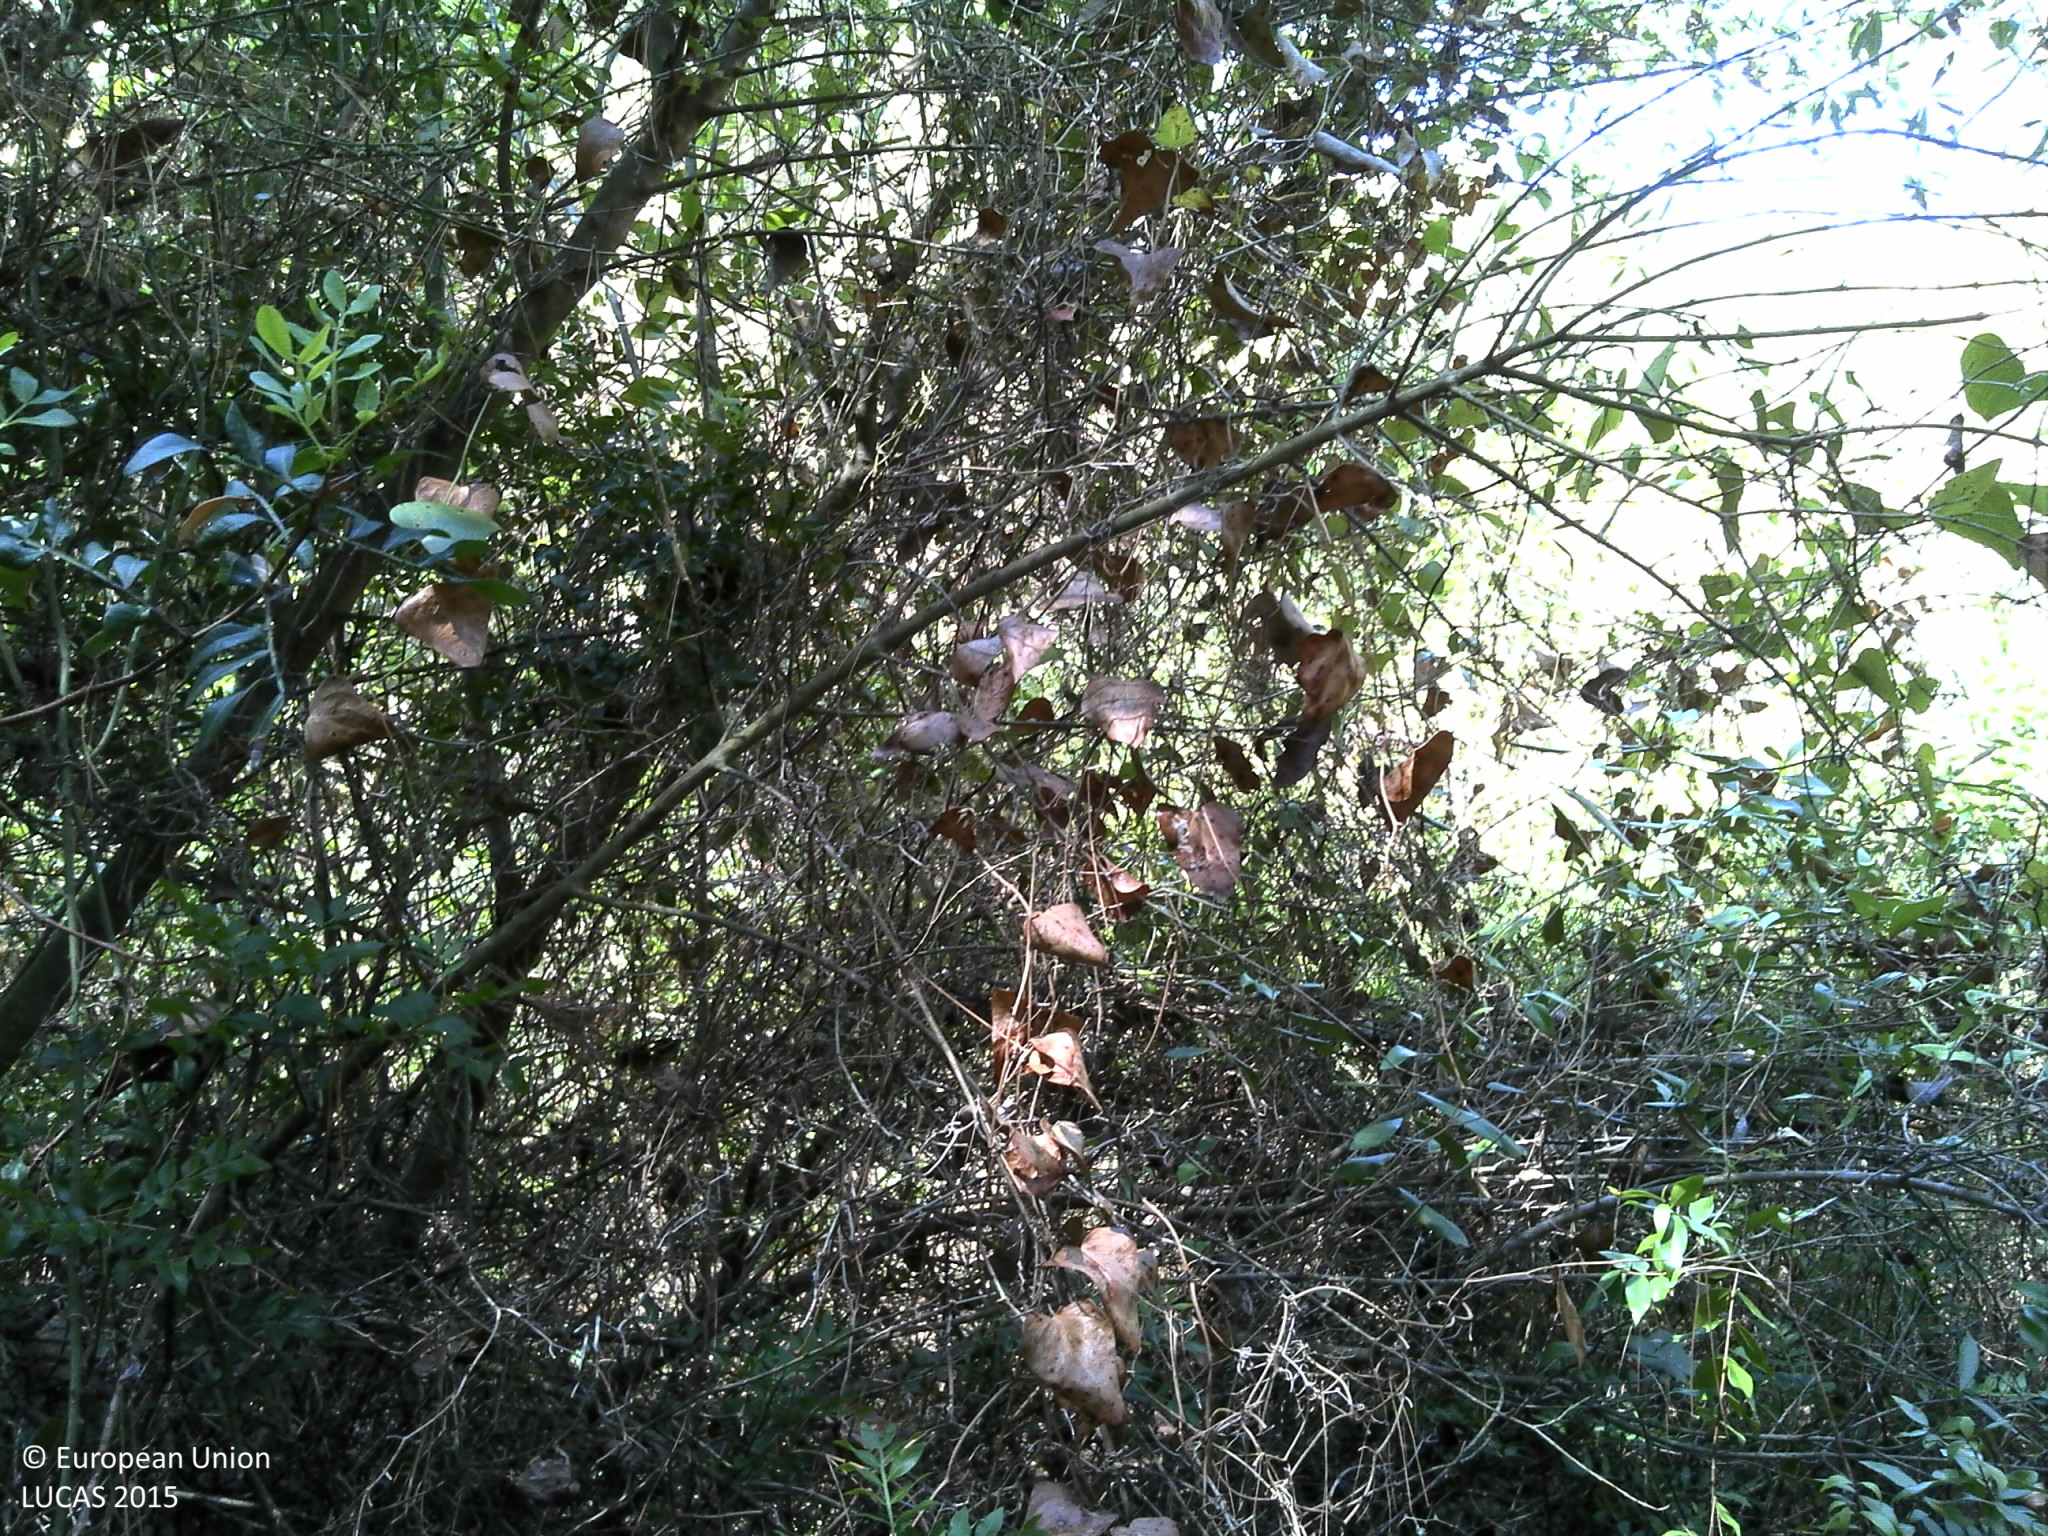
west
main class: Woodland
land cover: Pine dominated coniferous woodland
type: coniferous forest of the mediterranean region
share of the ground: > 75 %
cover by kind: coniferous forest trees 80 %, shrubs 20 %
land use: Semi-natural and natural areas not in use
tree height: > 5 m
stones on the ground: < 10 %
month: July
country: HR
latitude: 43.5071
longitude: 16.3111
